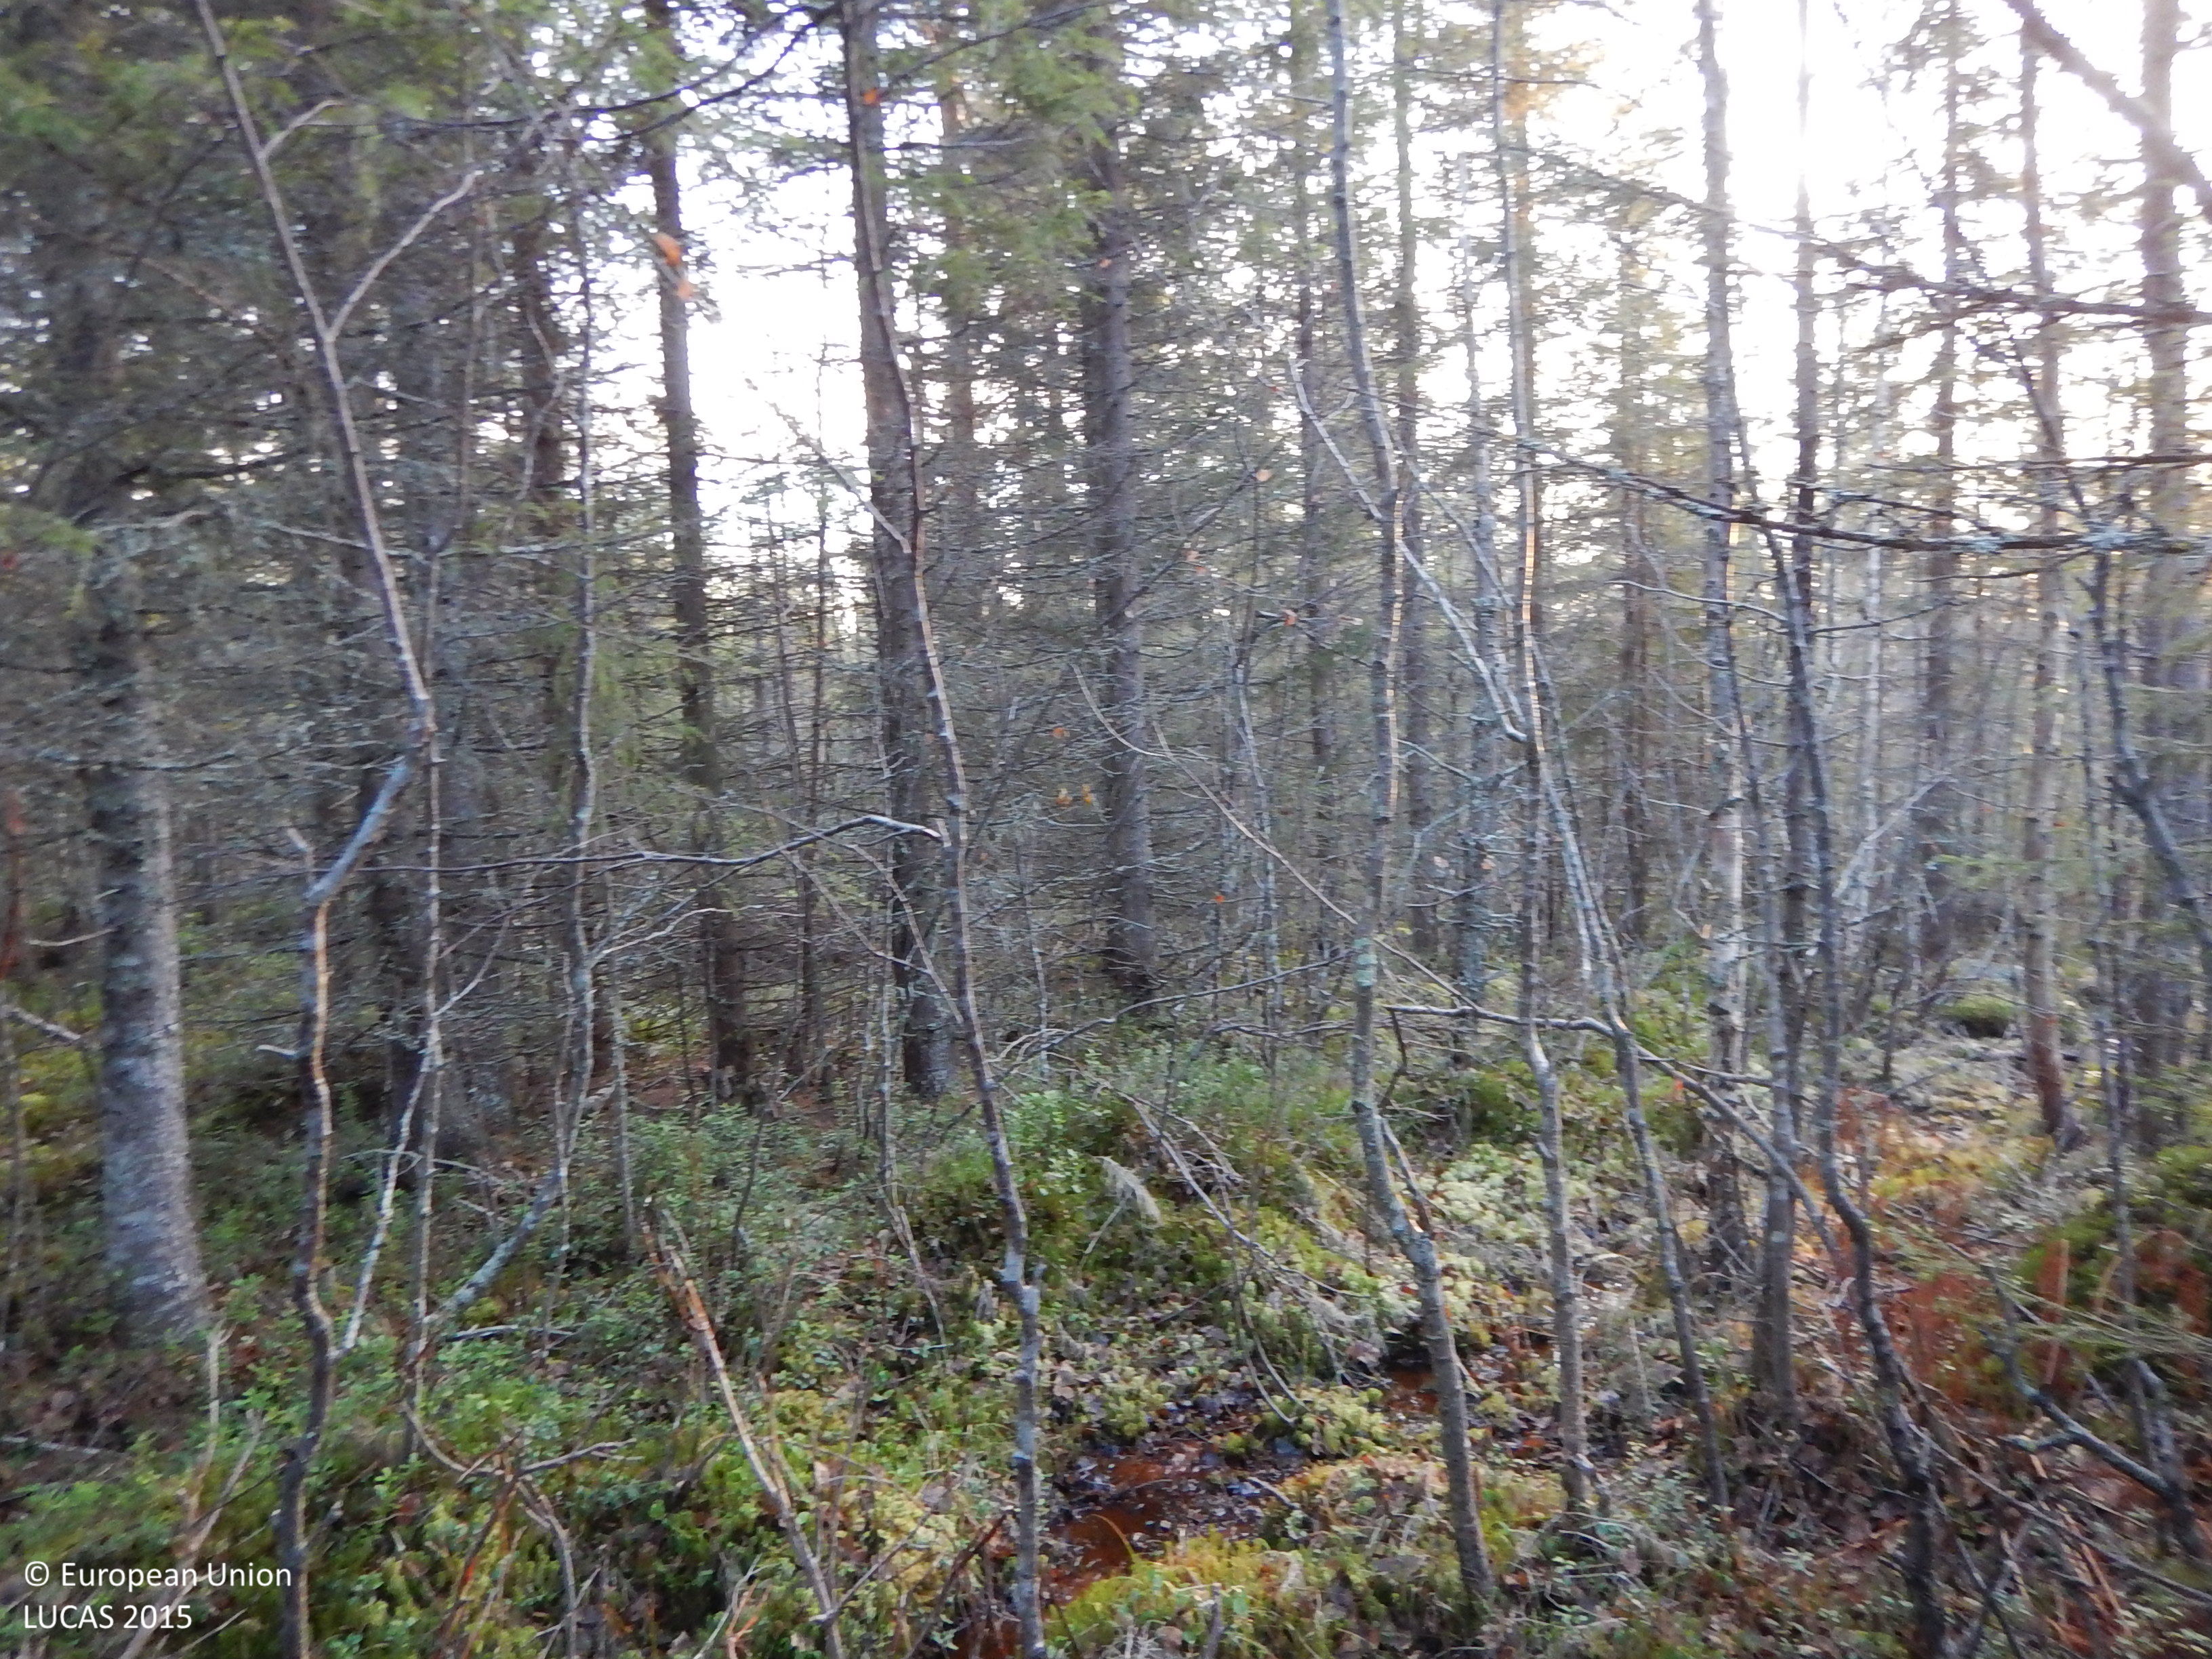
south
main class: Woodland
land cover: Spruce dominated mixed woodland
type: boreal forest
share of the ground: 50 - 75 %
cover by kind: coniferous forest trees 40 %, broadleaved forest trees 20 %, lichens and mosses 20 %, shrubs 10 %, herbaceous plants 10 %
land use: Forestry
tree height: > 5 m
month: November
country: SE
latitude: 65.2320
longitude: 20.5594
